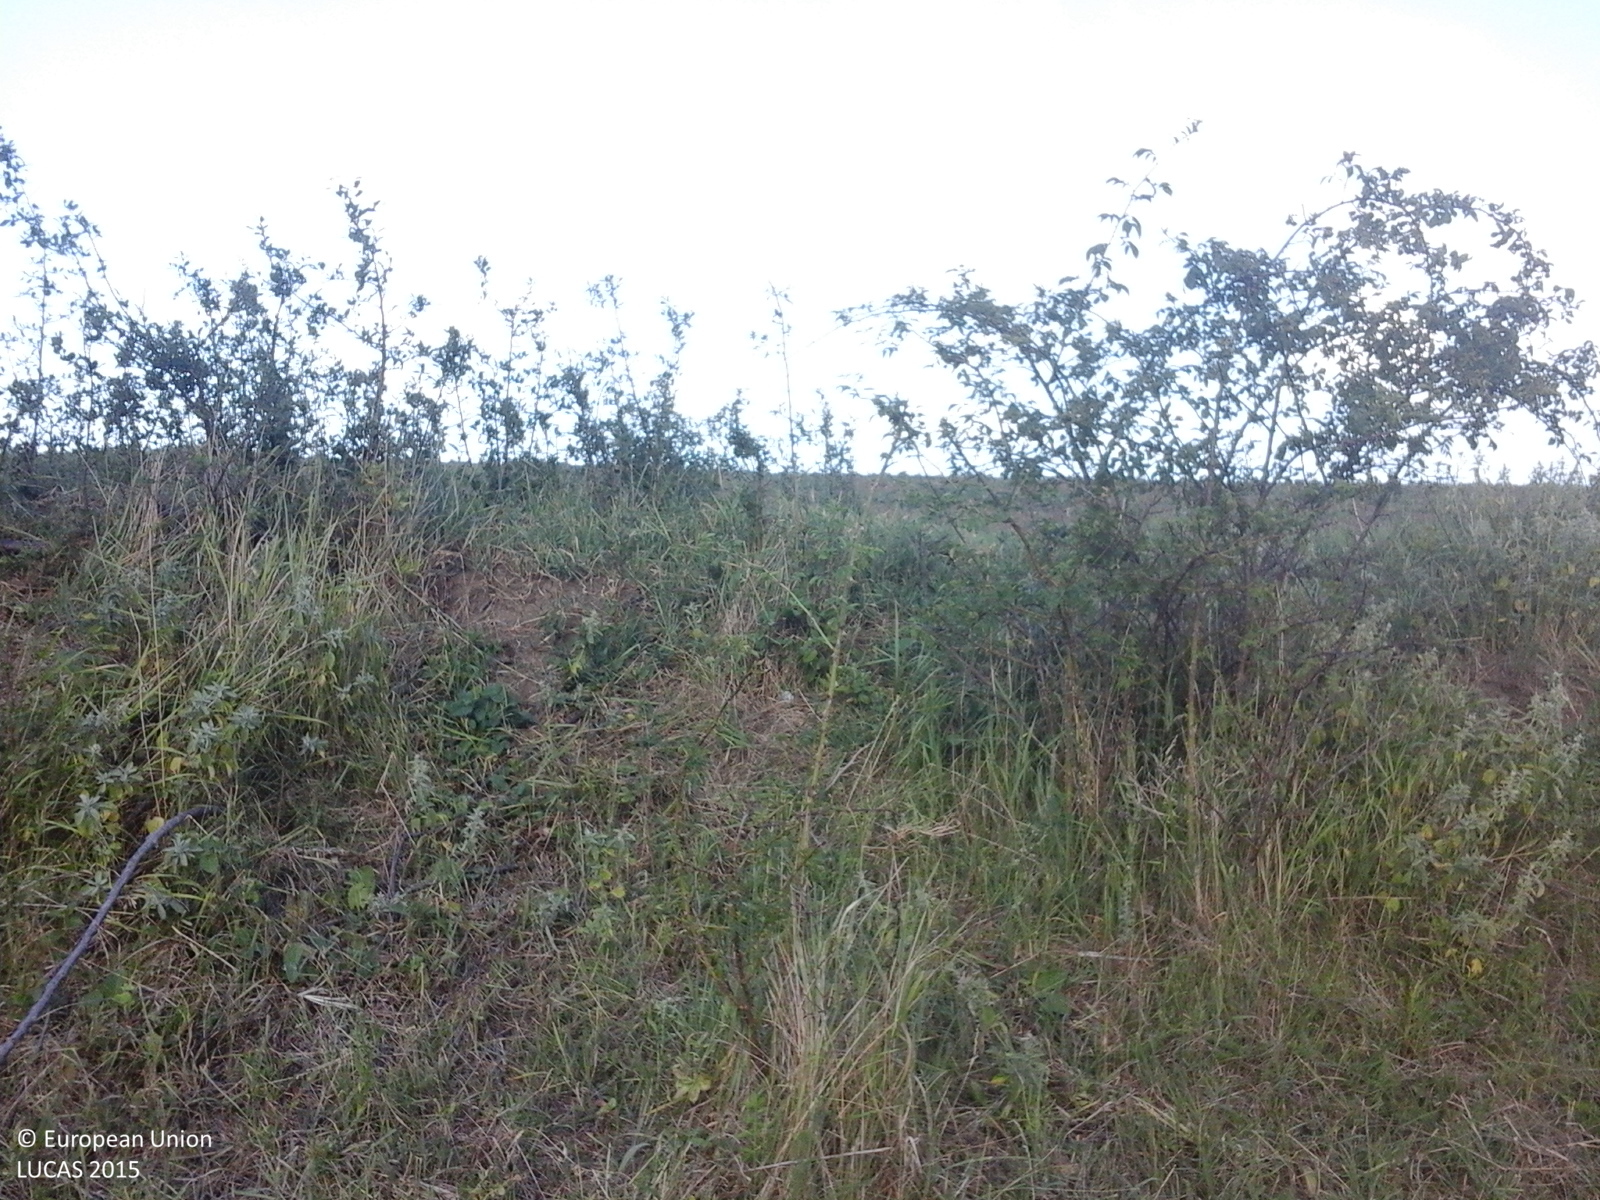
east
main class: Grassland
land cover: Grassland with sparse tree/shrub cover
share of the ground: > 75 %
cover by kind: herbaceous plants 85 %, shrubs 10 %, broadleaved forest trees 5 %
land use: Agriculture (excluding fallow land and kitchen gardens)
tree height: < 5 m
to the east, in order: Grassland with sparse tree/shrub cover; Maize; Fences; Vineyards; Maize; Lines of trees; Maize
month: June
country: RO
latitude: 47.1834
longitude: 27.0055
